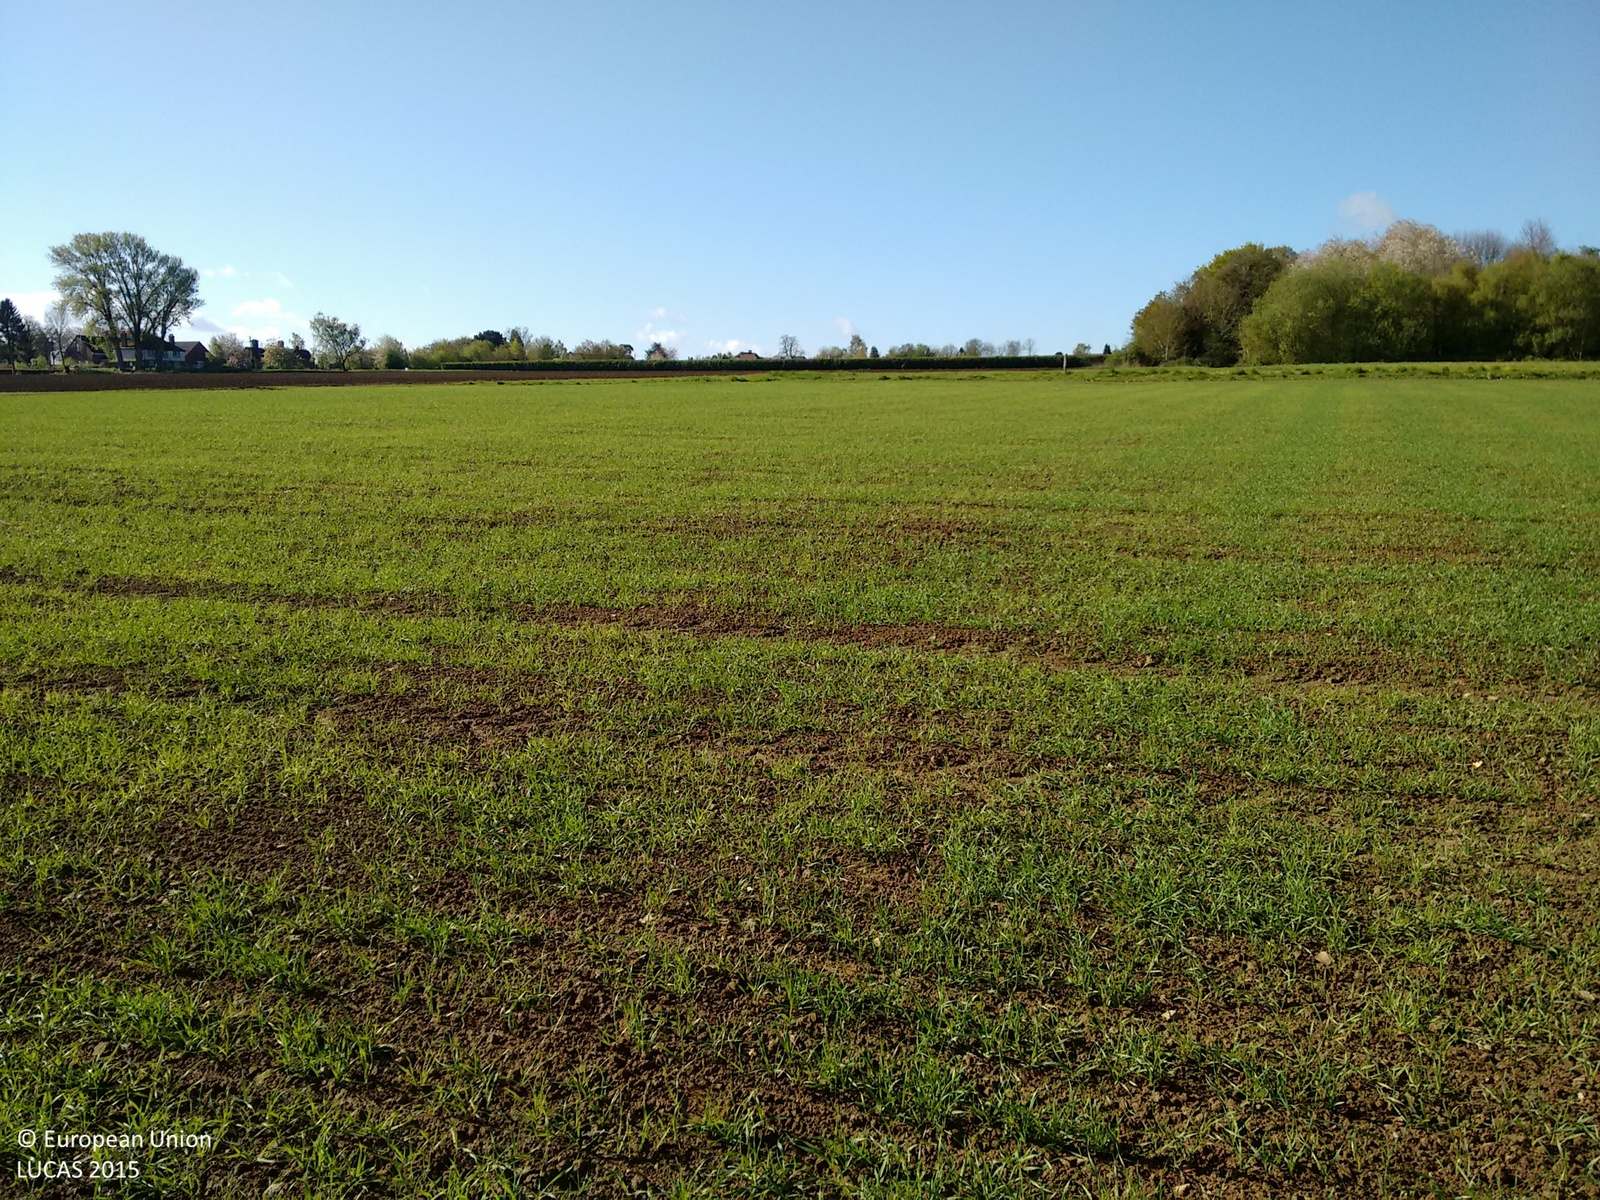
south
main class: Cropland
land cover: Common wheat
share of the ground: 25 - 50 %
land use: Agriculture (excluding fallow land and kitchen gardens)
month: April
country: GB
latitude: 51.2975
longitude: 0.3762
